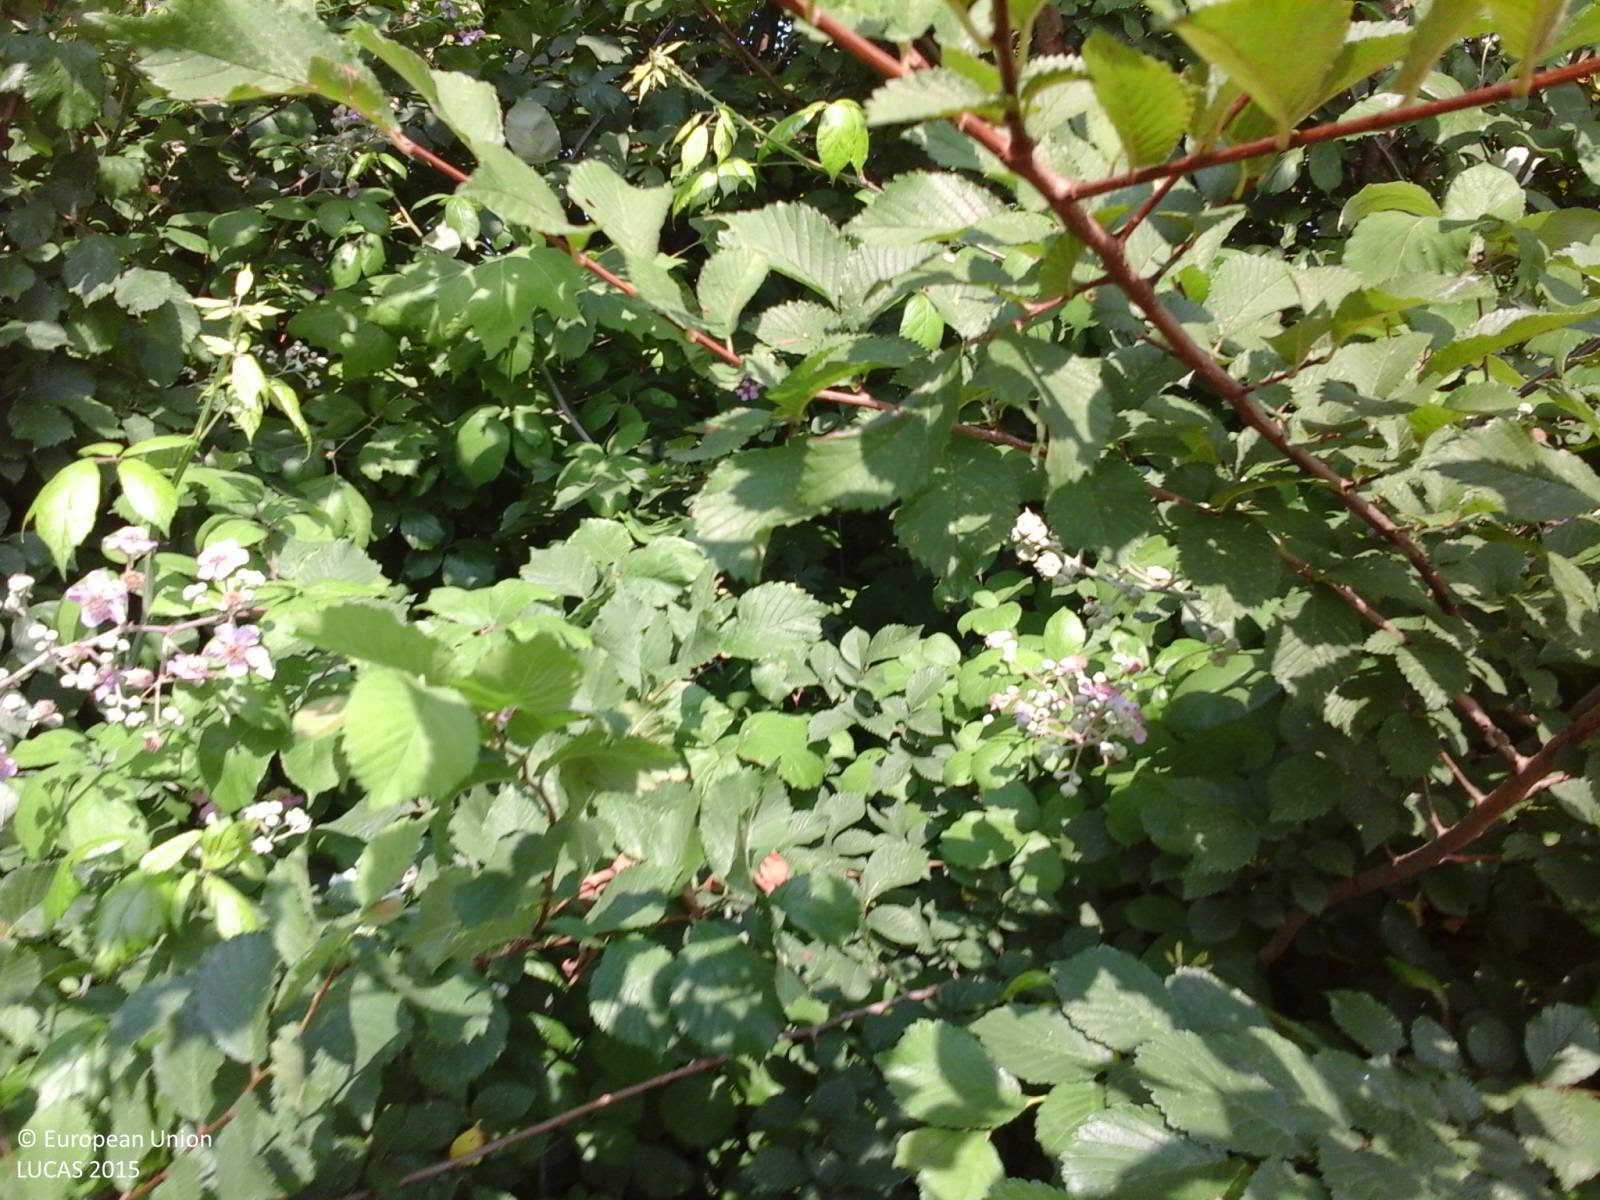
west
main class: Cropland
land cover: Maize
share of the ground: < 10 %
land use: Agriculture (excluding fallow land and kitchen gardens)
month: June
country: IT
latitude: 45.9625
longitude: 12.4614
